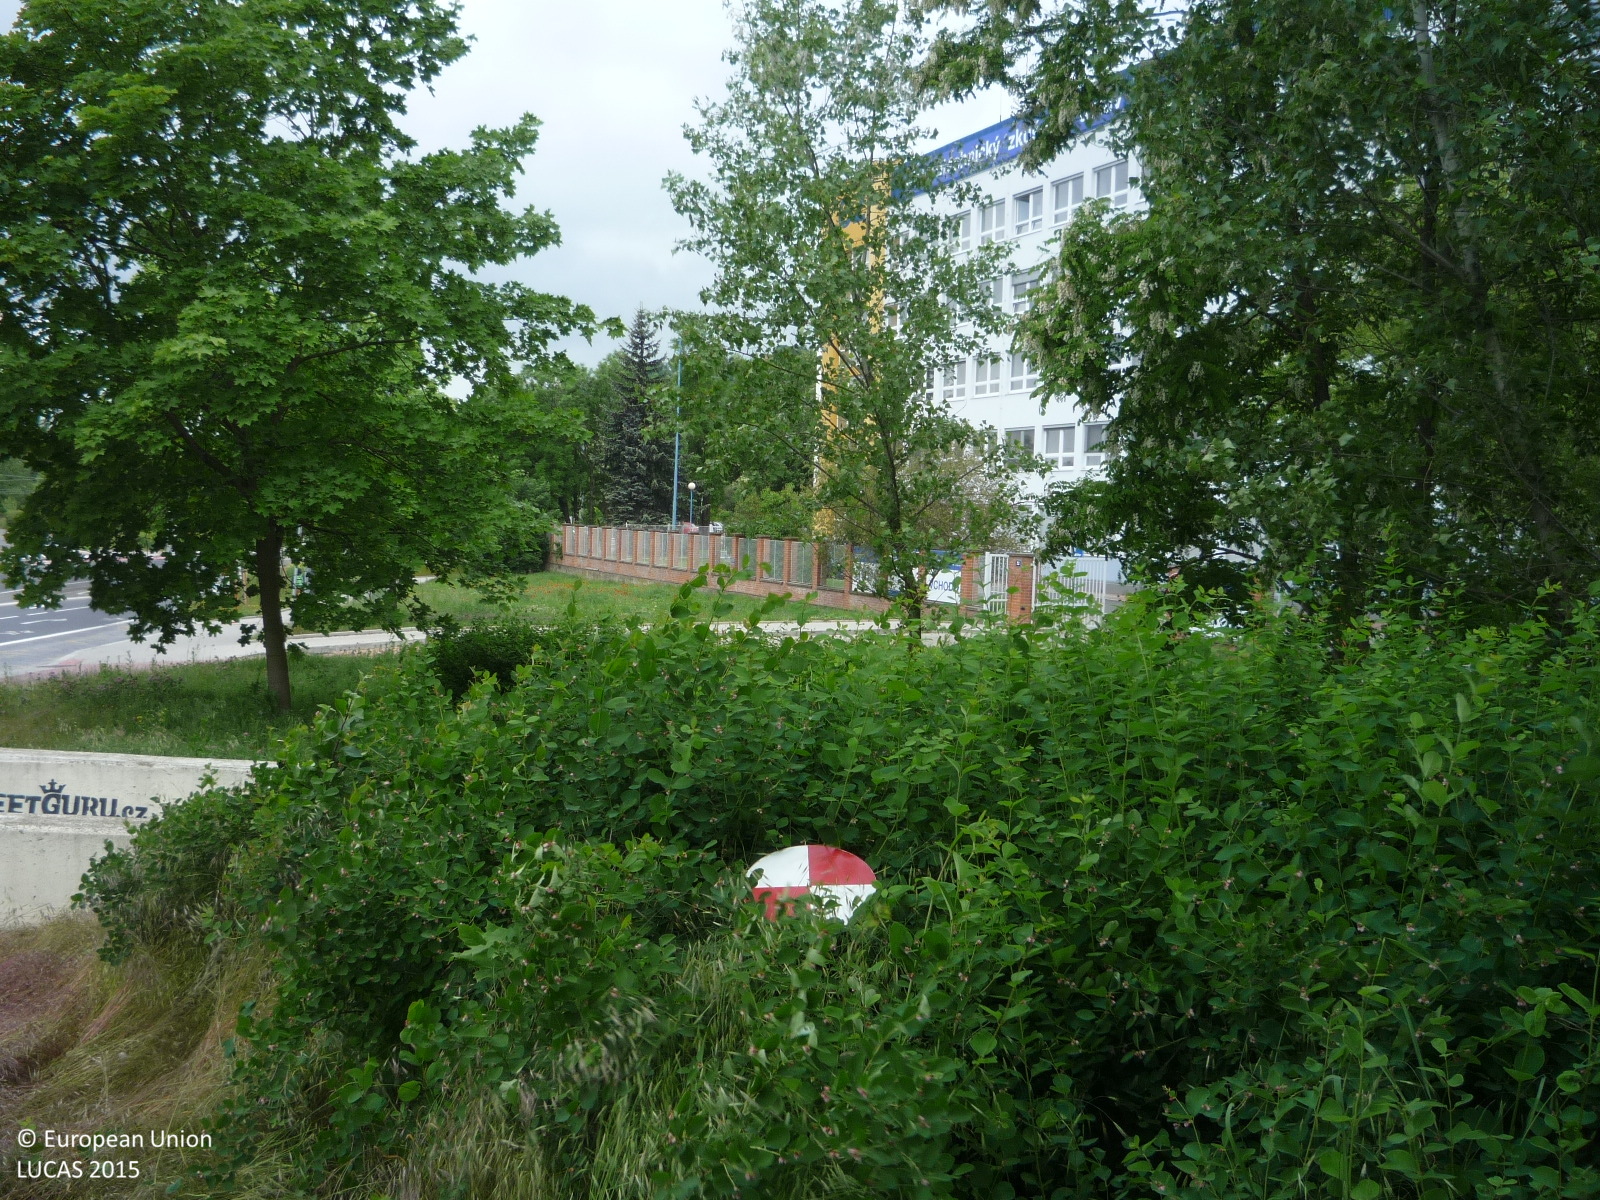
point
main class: Shrubland
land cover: Shrubland with sparse tree cover
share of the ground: > 75 %
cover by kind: shrubs 85 %, herbaceous plants 10 %, broadleaved forest trees 5 %
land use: Financial, professional and information services
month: May
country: CZ
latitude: 50.1160
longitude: 14.4348
